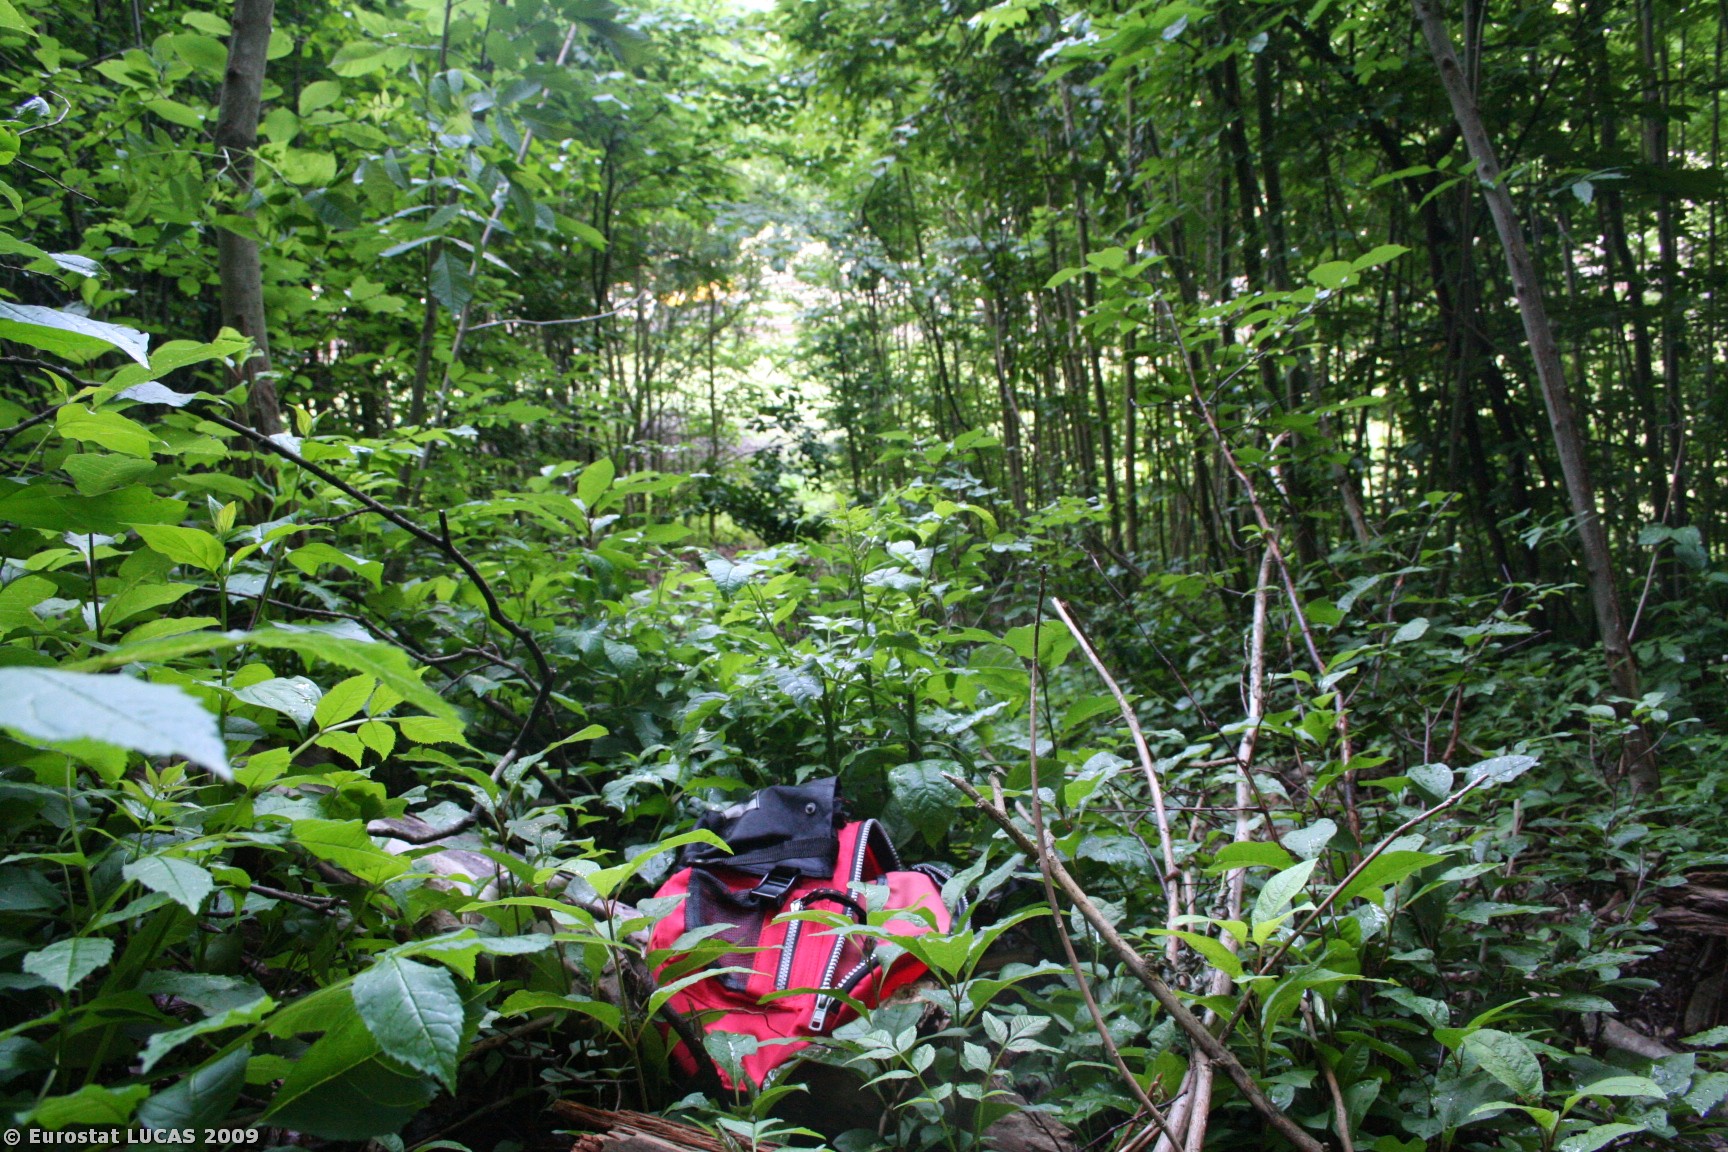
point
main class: Woodland
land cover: Broadleaved woodland
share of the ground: > 75 %
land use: Forestry
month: June
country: AT
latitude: 47.4748
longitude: 13.1961
